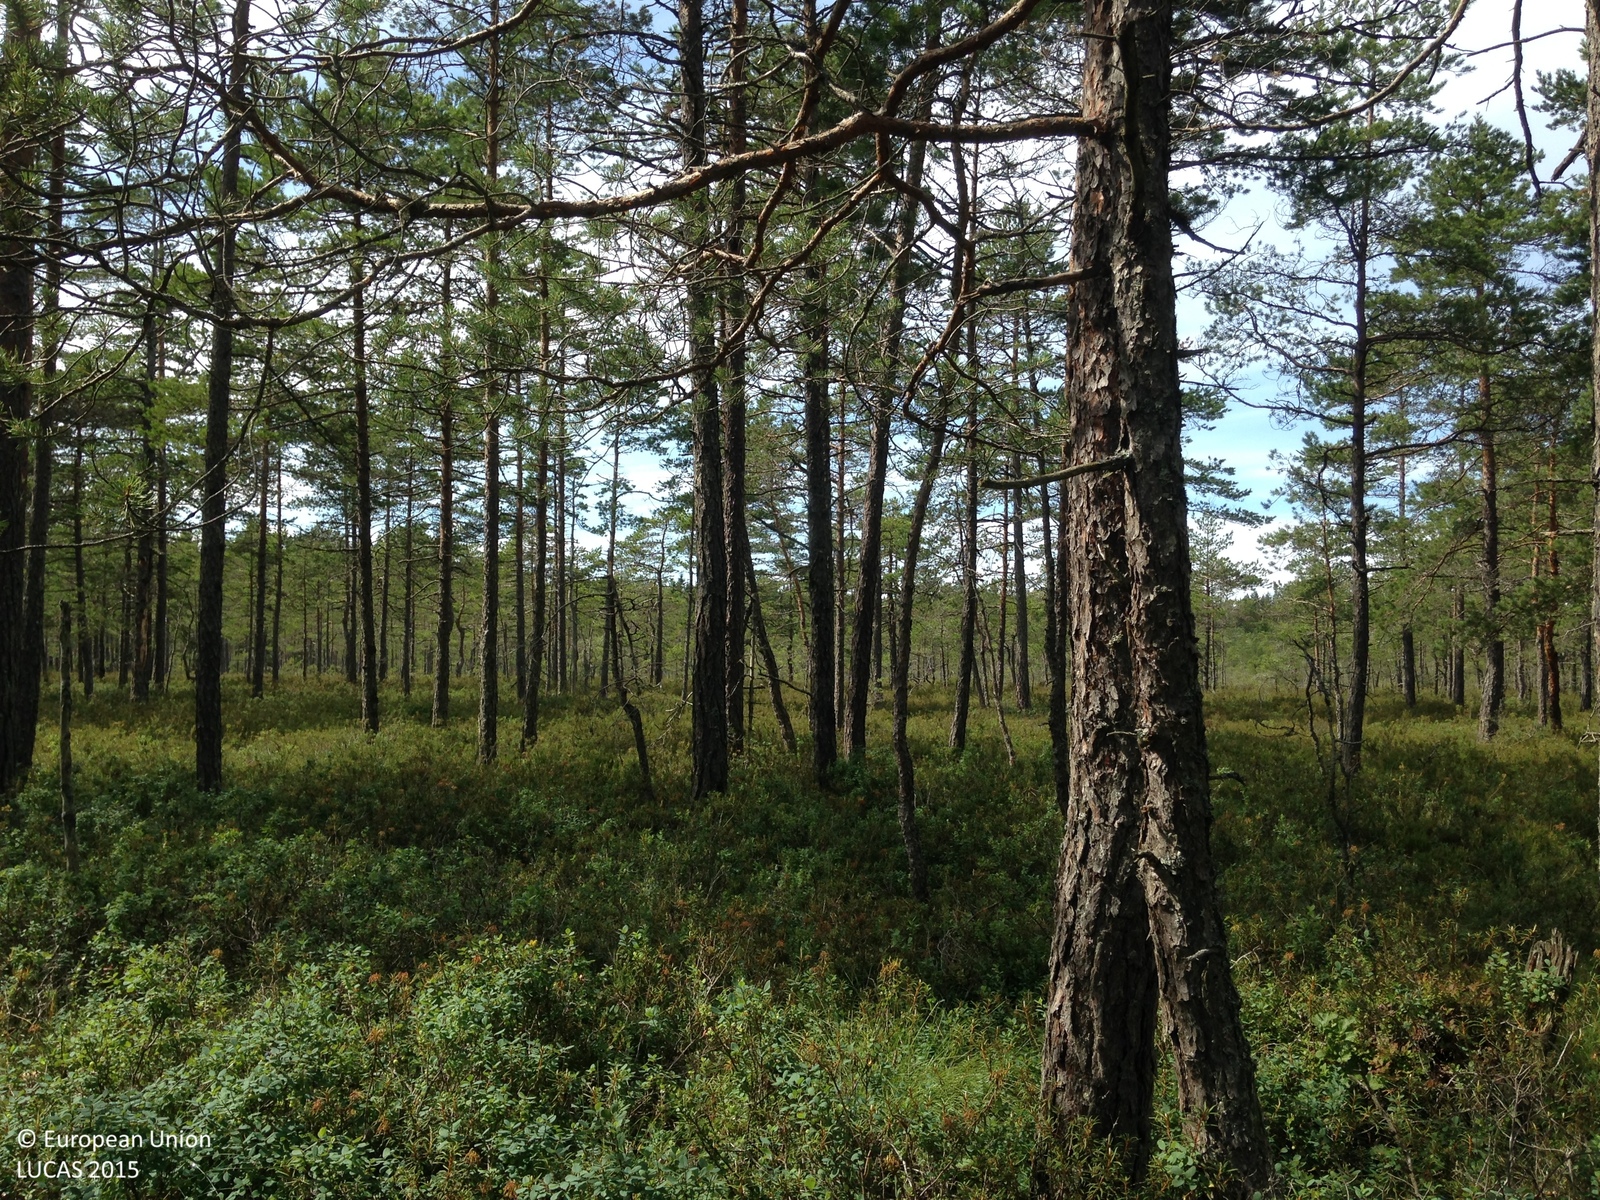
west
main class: Woodland
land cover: Pine dominated coniferous woodland
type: boreal forest
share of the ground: 10 - 25 %
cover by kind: shrubs 50 %, coniferous forest trees 20 %, lichens and mosses 20 %, herbaceous plants 10 %
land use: Forestry
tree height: > 5 m
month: July
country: SE
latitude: 58.9744
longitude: 14.4627
